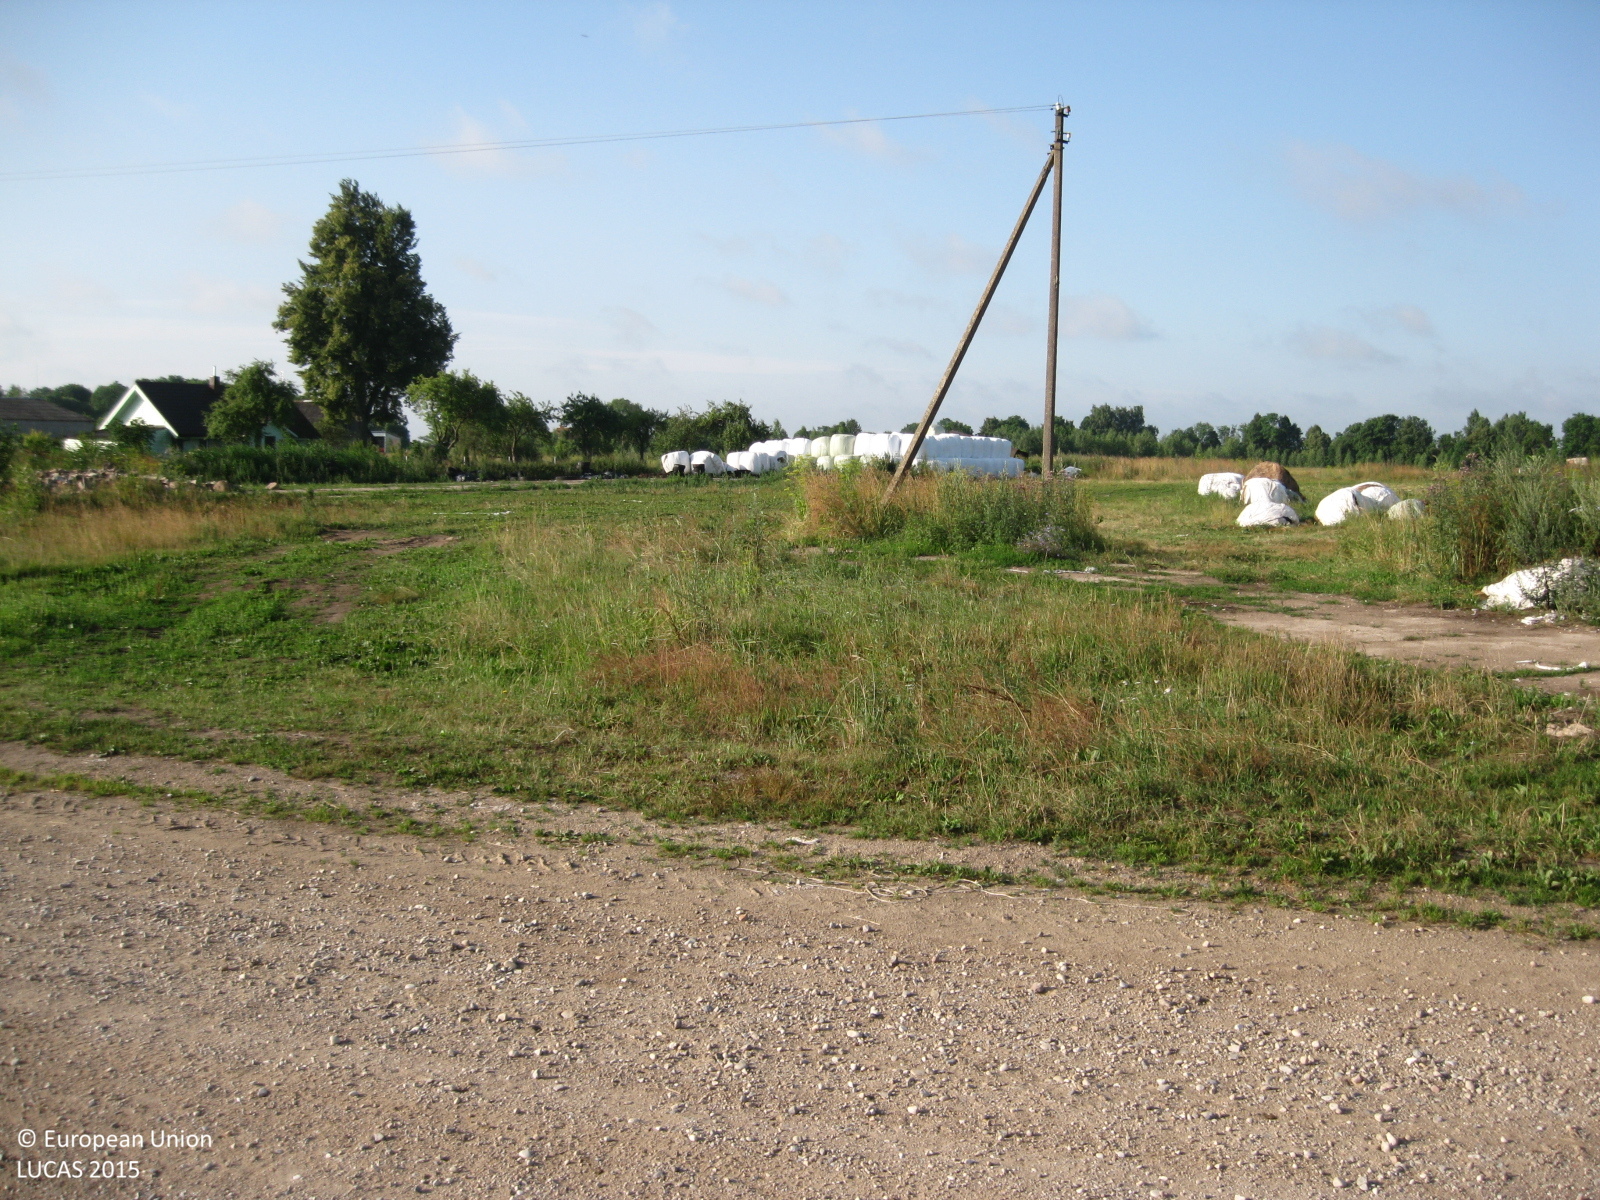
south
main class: Grassland
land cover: Grassland without tree/shrub cover
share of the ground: > 75 %
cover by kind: herbaceous plants 100 %
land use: Agriculture (excluding fallow land and kitchen gardens)
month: July
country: LT
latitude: 55.3118
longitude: 24.5819
